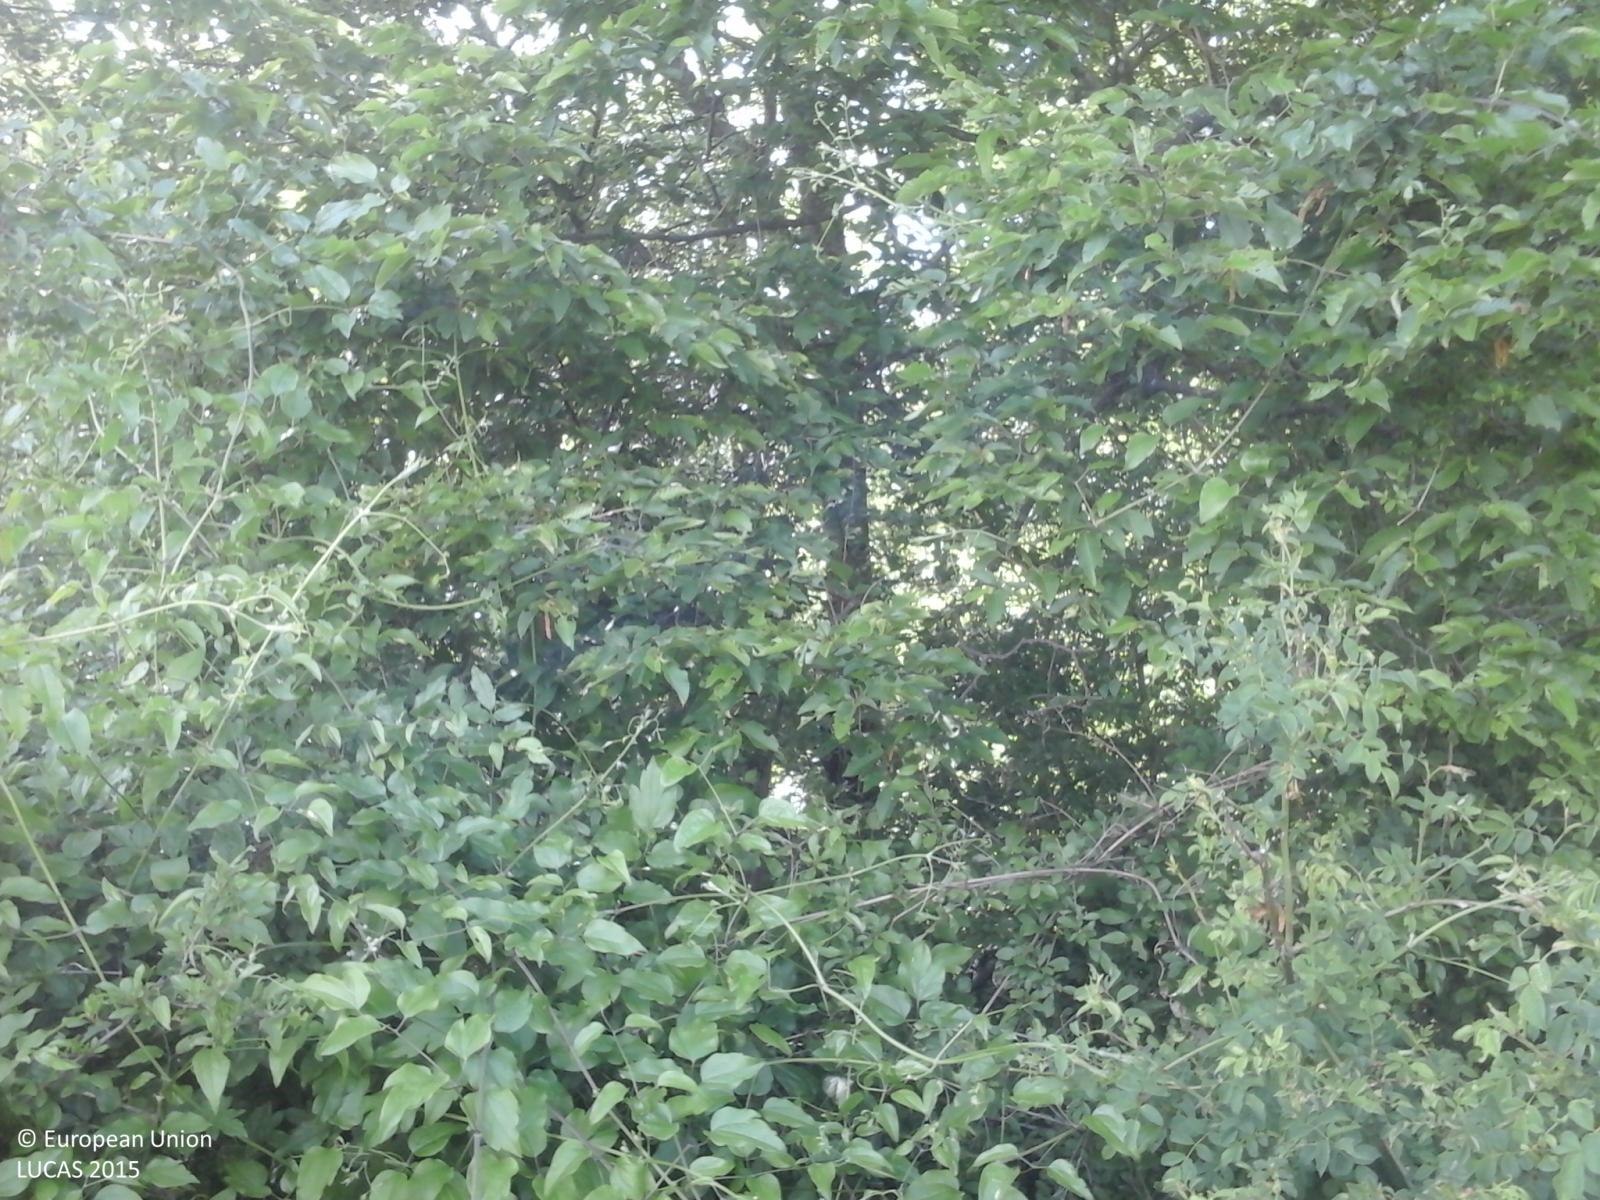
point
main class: Woodland
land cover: Broadleaved woodland
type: thermophilous deciduous forest
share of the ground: > 75 %
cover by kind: broadleaved forest trees 90 %, shrubs 10 %
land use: Forestry
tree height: > 5 m
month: May
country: IT
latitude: 44.2025
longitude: 10.8863
